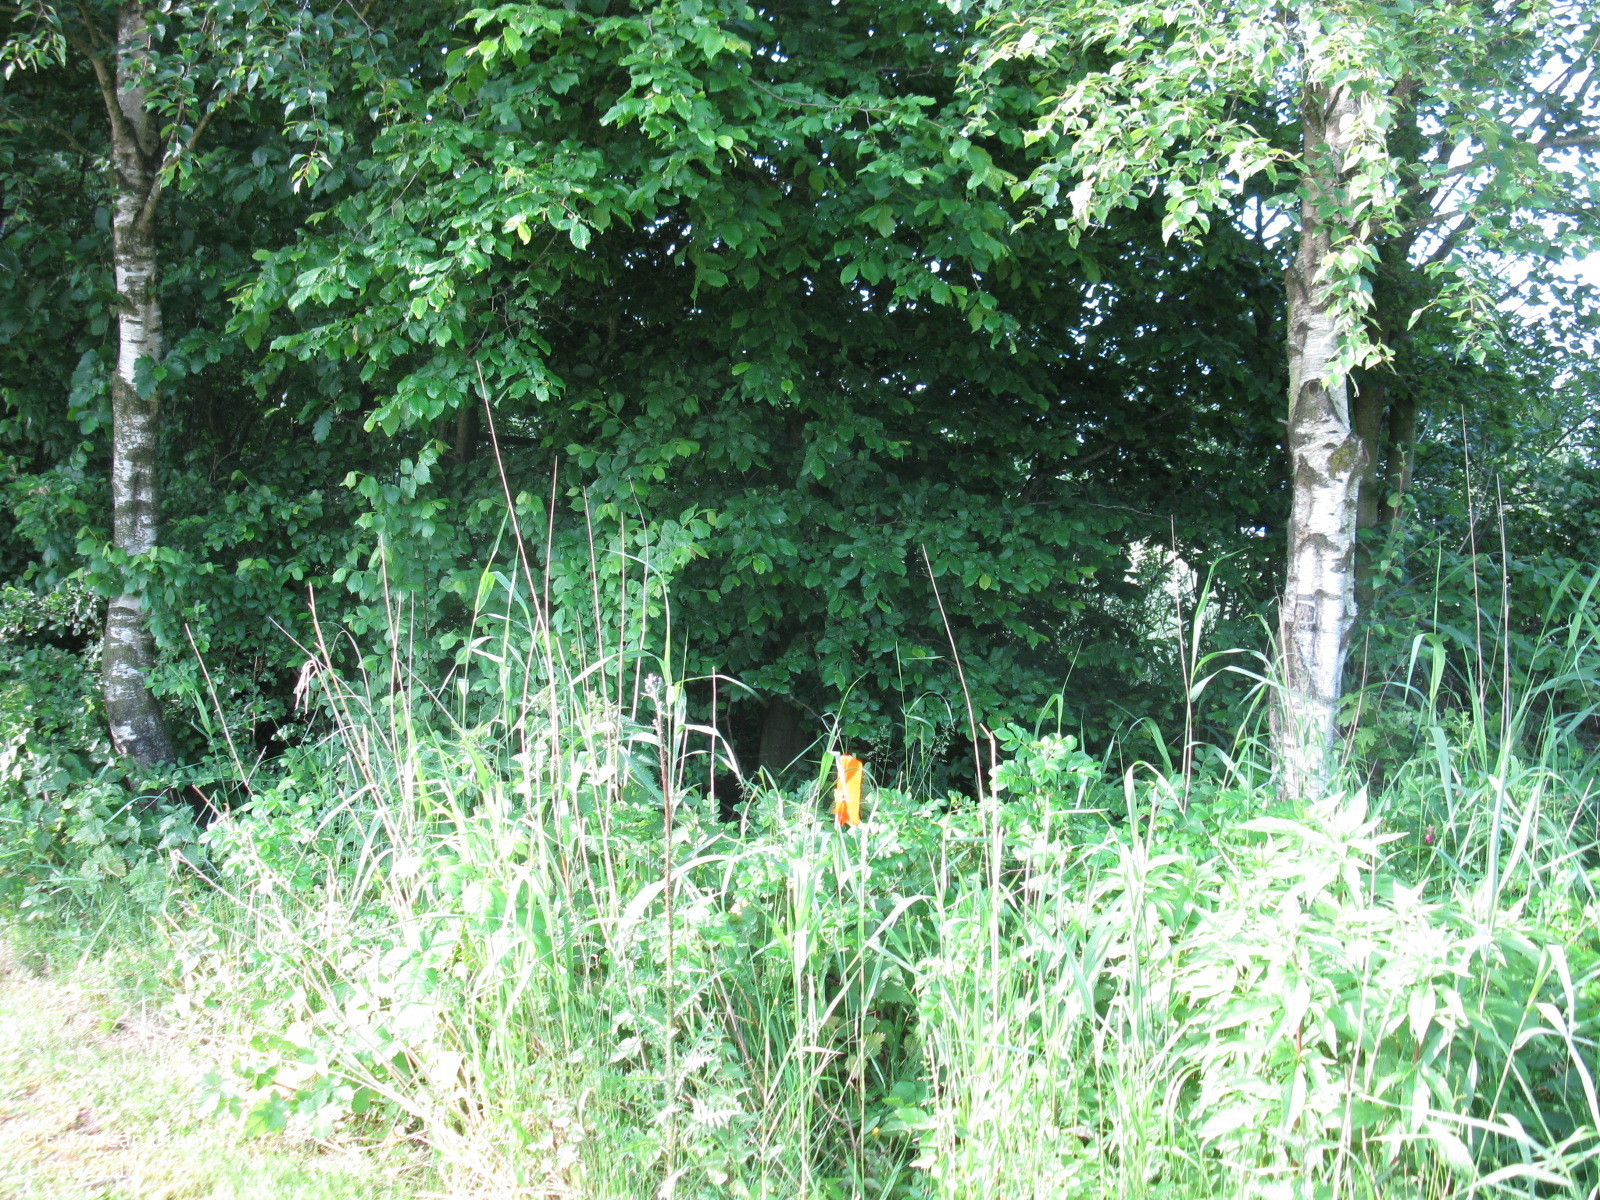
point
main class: Woodland
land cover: Broadleaved woodland
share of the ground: > 75 %
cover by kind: broadleaved forest trees 100 %
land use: Commerce
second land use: Amenities, museums, leisure
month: June
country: DE
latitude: 53.4439
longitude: 7.3057
